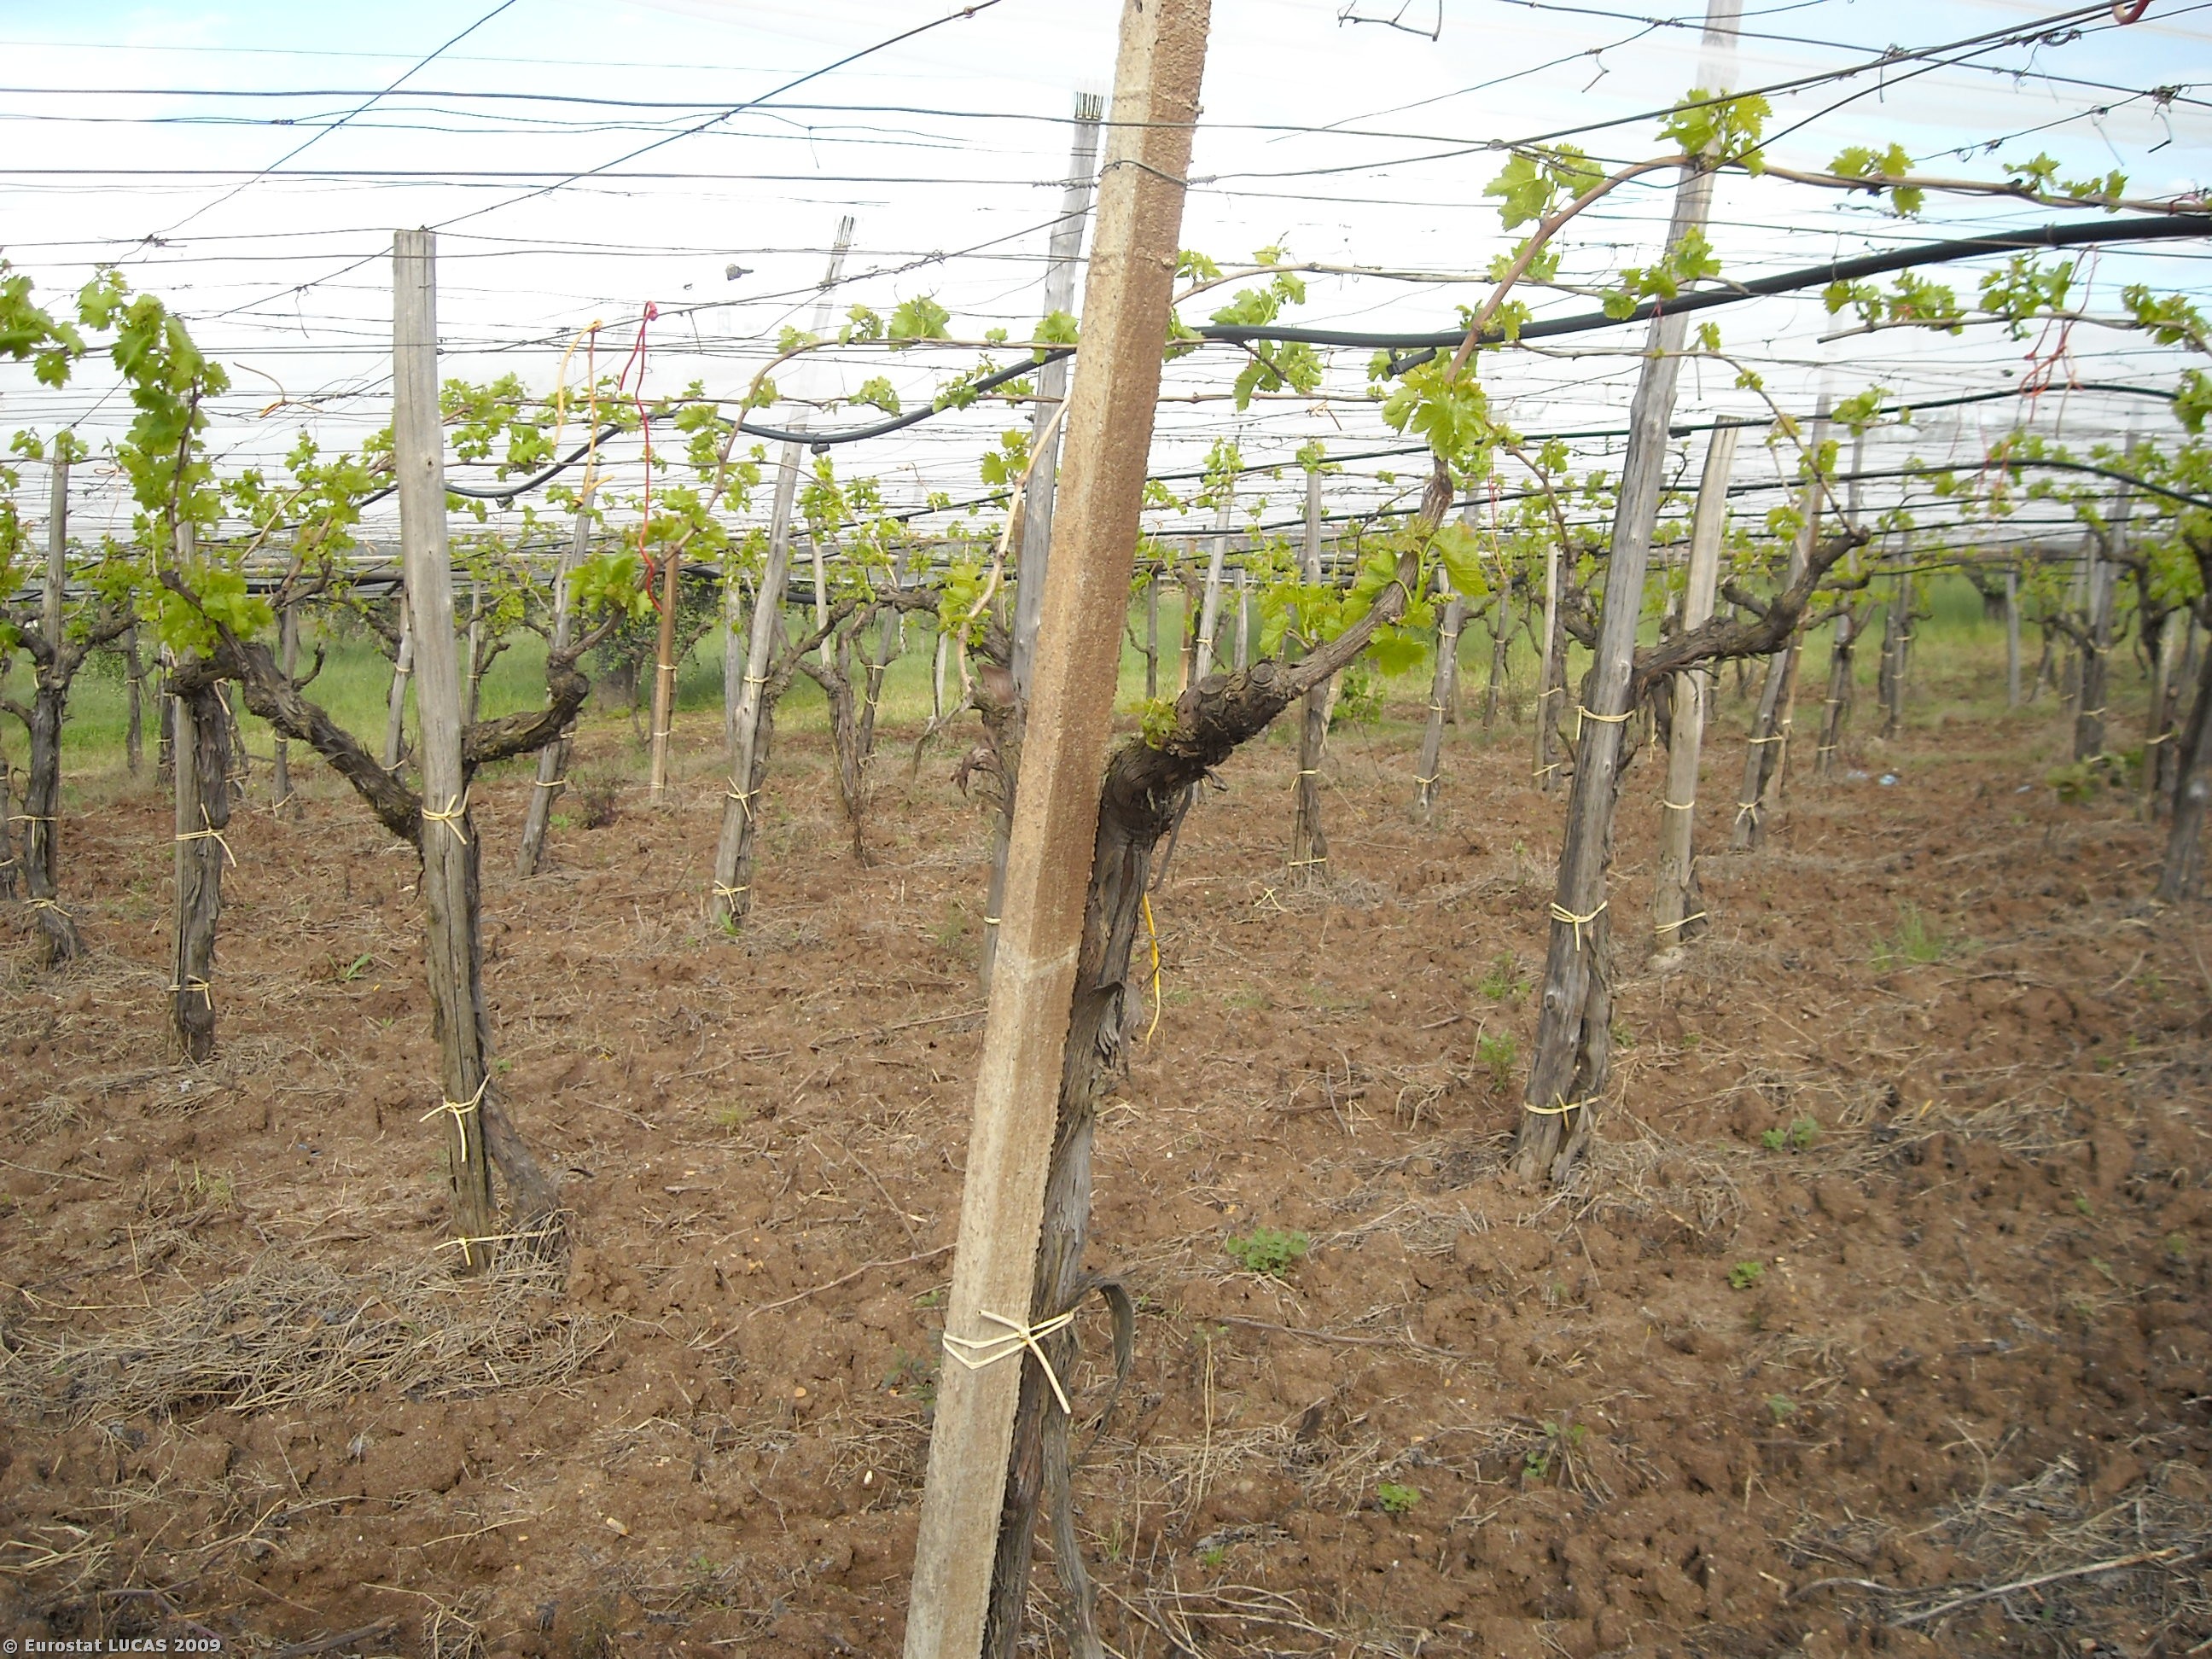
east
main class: Cropland
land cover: Vineyards
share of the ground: > 75 %
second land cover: Bare land
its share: > 75 %
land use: Agriculture (excluding fallow land and kitchen gardens)
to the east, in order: Vineyards; Bare land; Olive groves; Grass margins; Paved roads, cycling and walking lanes; Grass margins; Bare land; Electric lines; Bare land; Vineyards; Bare land; Paved roads, cycling and walking lanes; Bare land; Electric lines; Bare land; Vineyards; Bare land; Electric lines; Grass margins; Paved roads, cycling and walking lanes; Bare land; Olive groves; Bare land; Vineyards
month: April
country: IT
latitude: 40.5010
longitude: 16.8316
